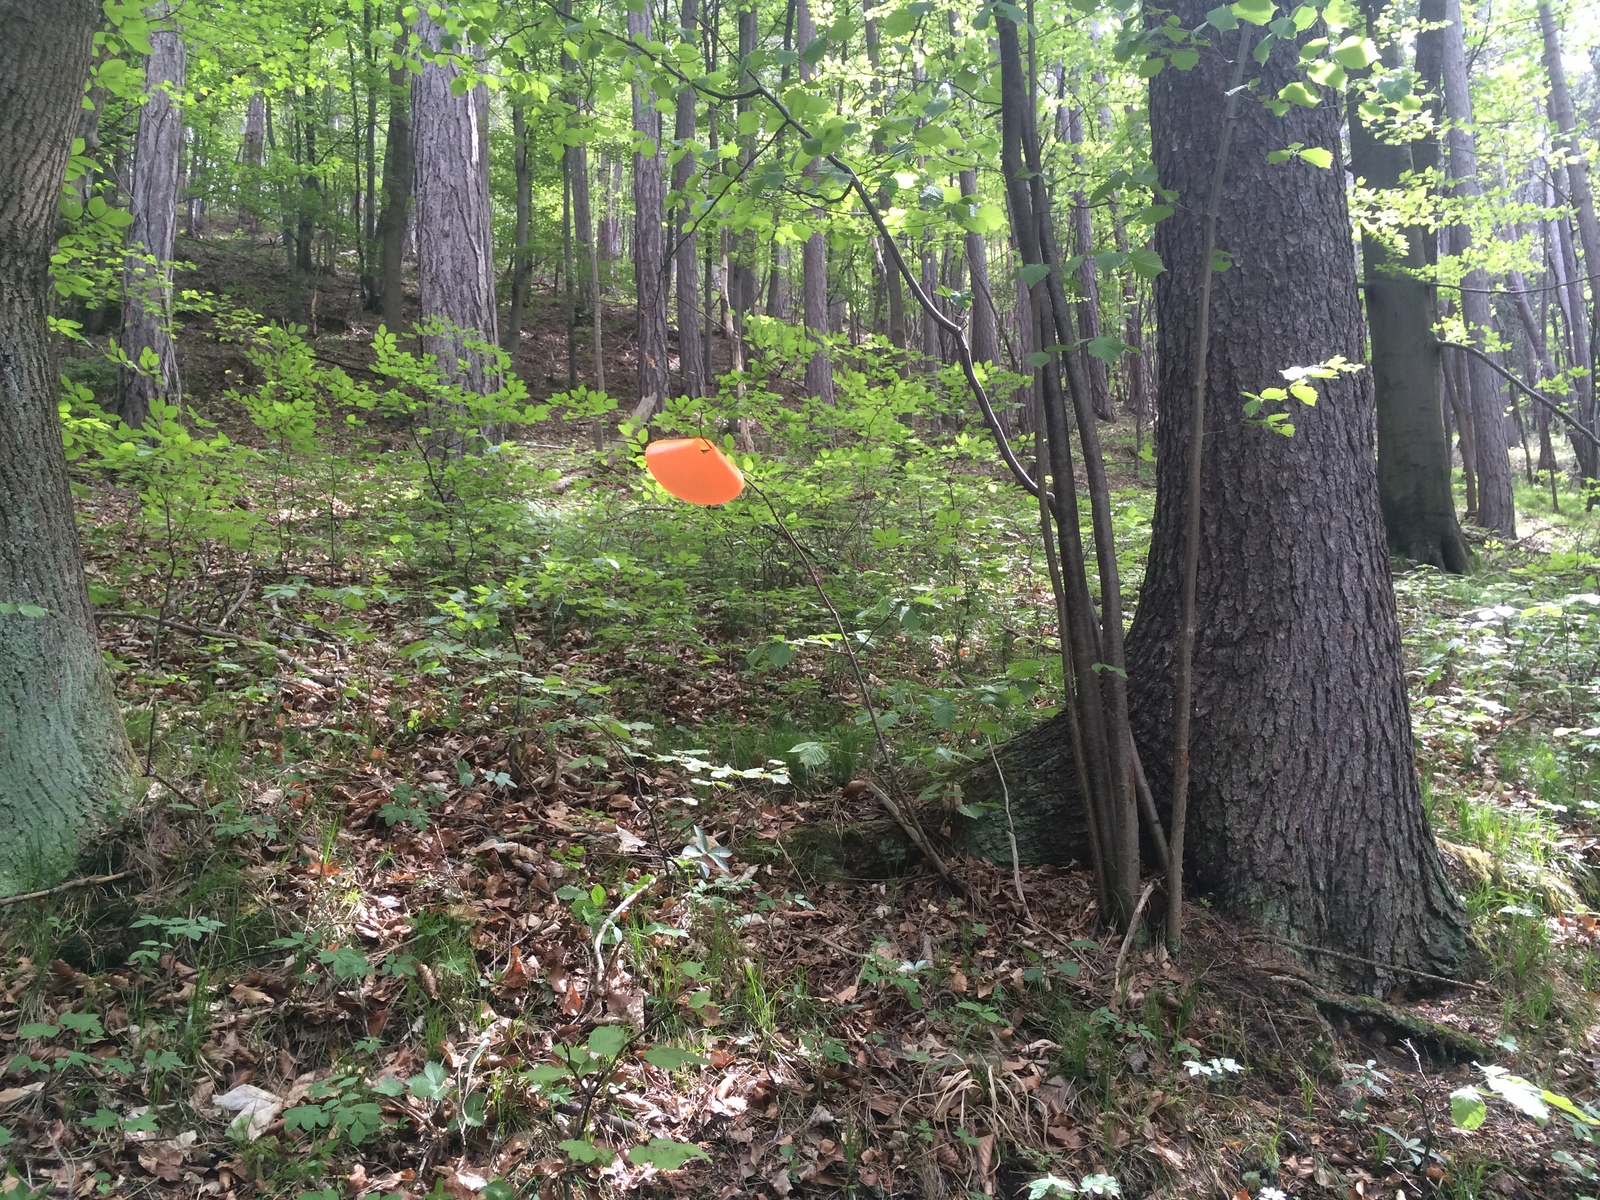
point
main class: Woodland
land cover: Other mixed woodland
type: alpine coniferous forest
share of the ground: > 75 %
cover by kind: broadleaved forest trees 60 %, coniferous forest trees 40 %
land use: Forestry
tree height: > 5 m
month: May
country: AT
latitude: 47.9078
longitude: 16.1445
